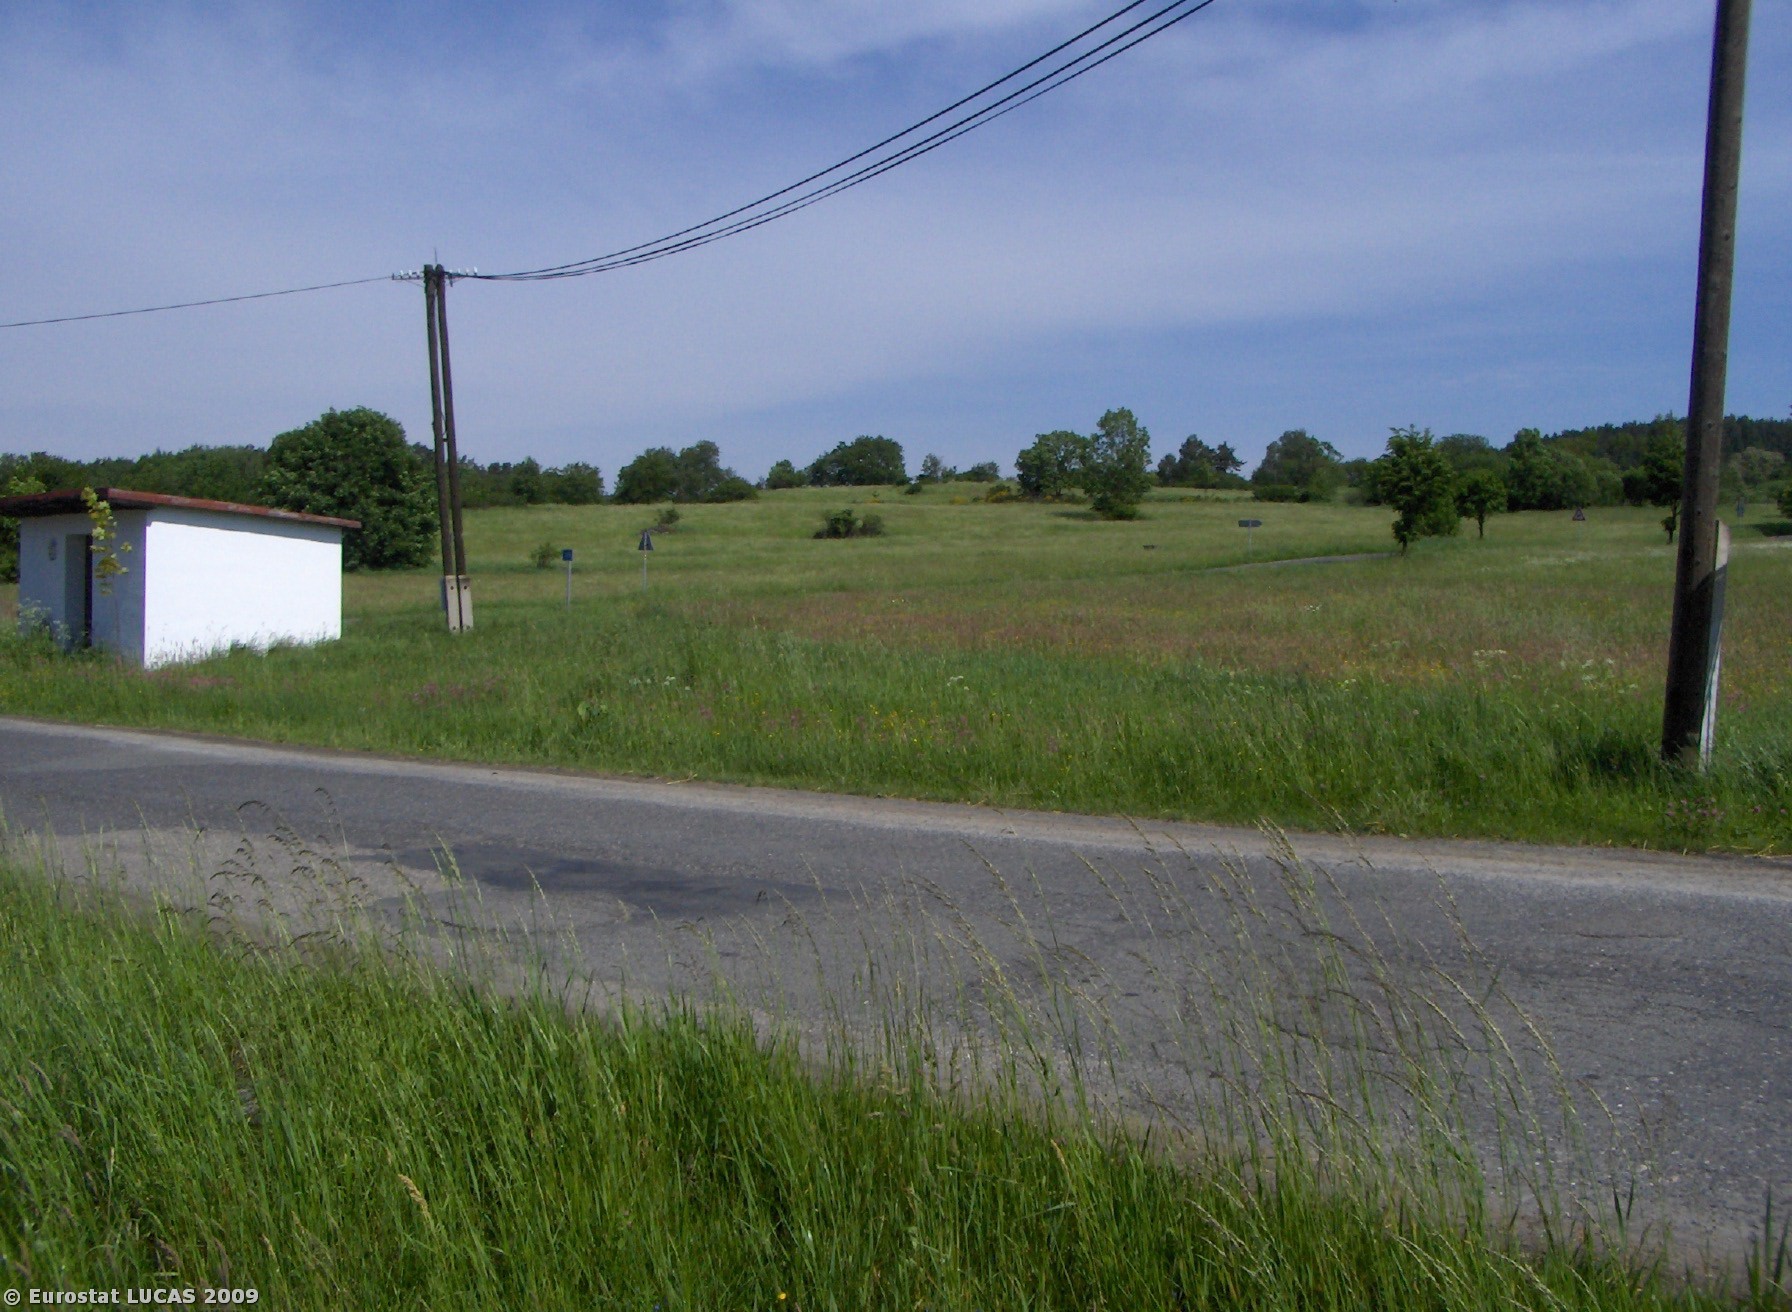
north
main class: Grassland
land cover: Grassland without tree/shrub cover
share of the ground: > 75 %
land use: Agriculture (excluding fallow land and kitchen gardens)
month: May
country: CZ
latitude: 49.5607
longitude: 14.3562
